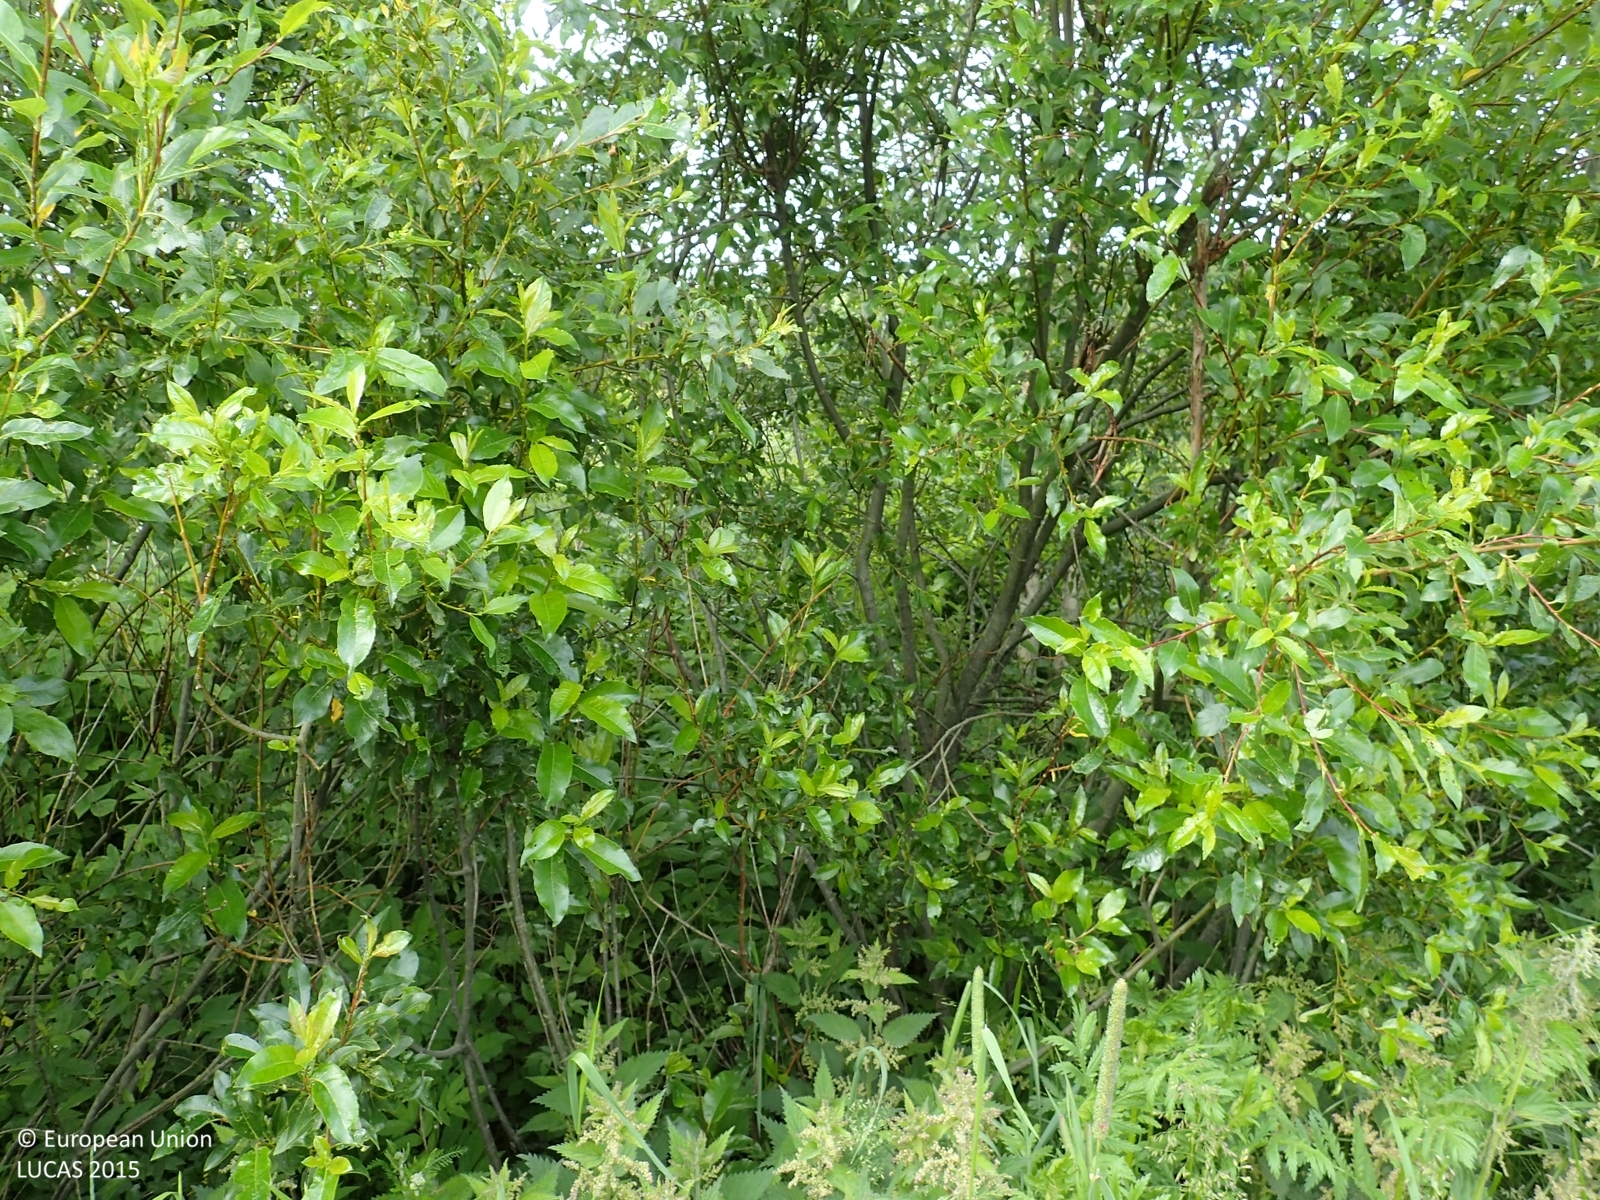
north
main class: Woodland
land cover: Broadleaved woodland
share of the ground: 50 - 75 %
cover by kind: broadleaved forest trees 55 %, herbaceous plants 45 %
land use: Semi-natural and natural areas not in use
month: June
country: FI
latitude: 62.5597
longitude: 21.4211
